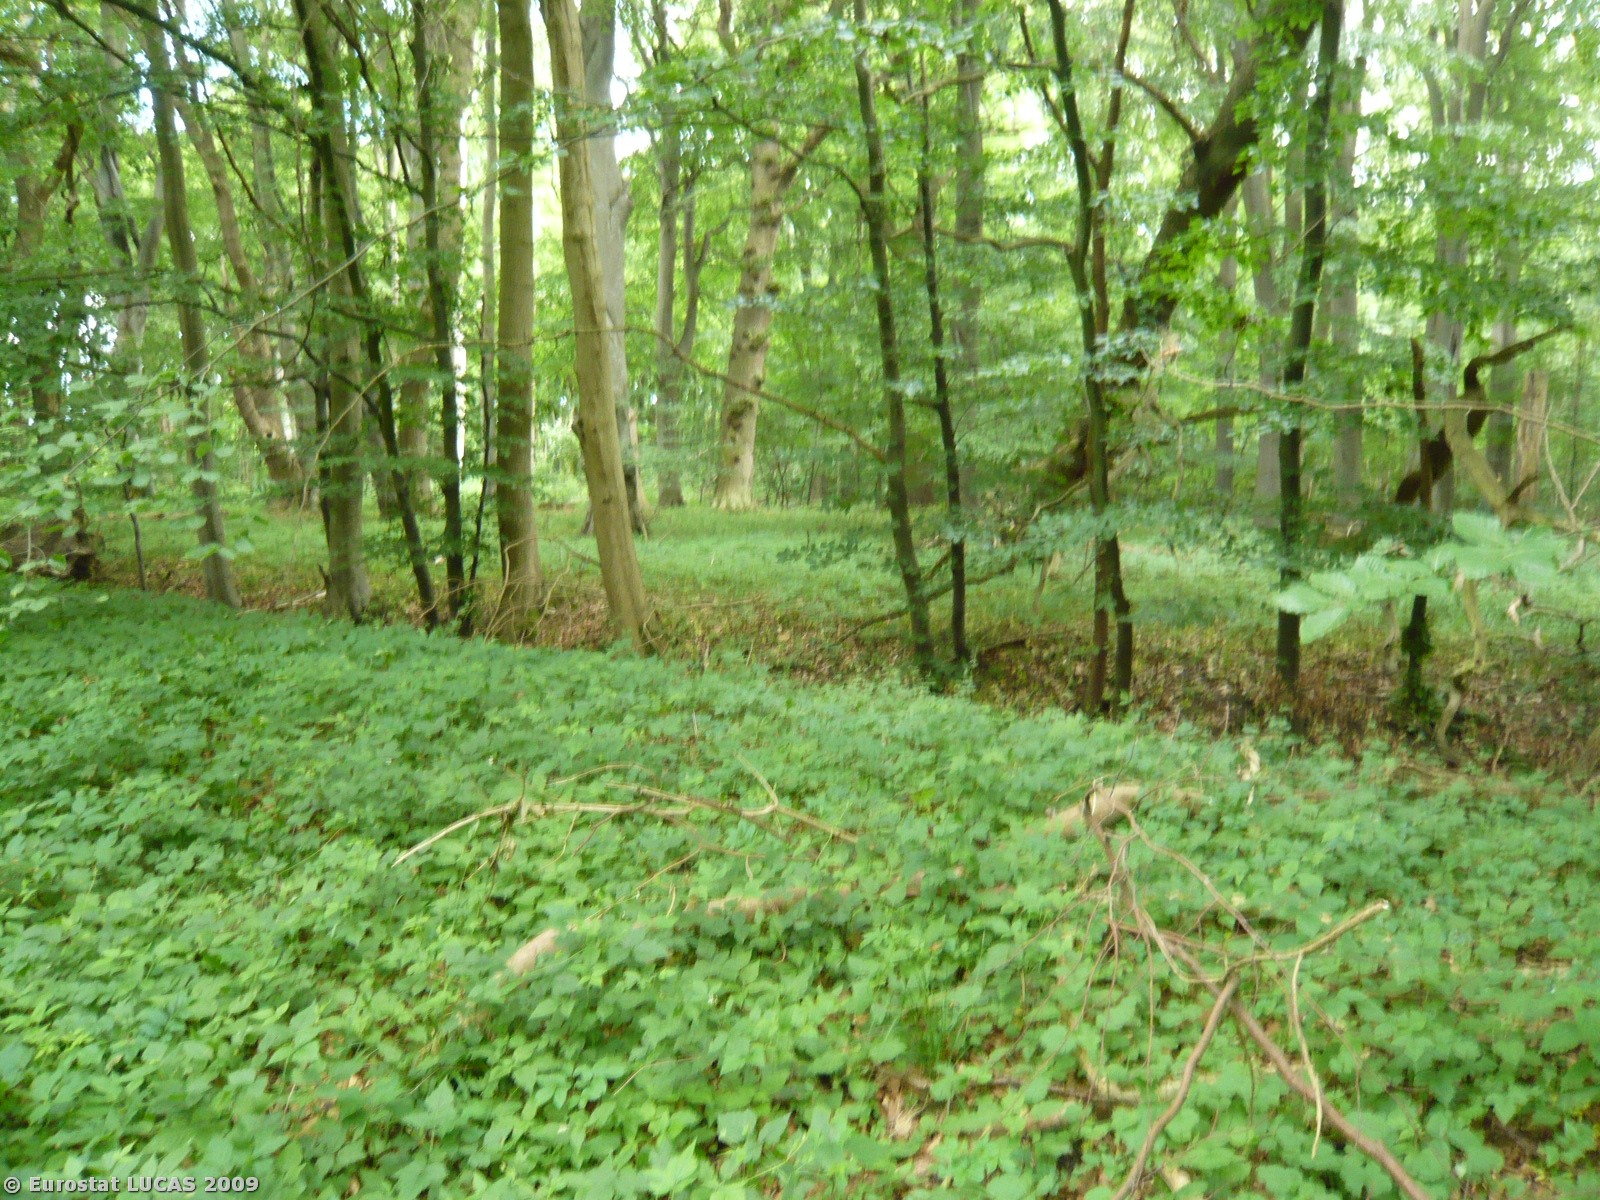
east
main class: Woodland
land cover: Broadleaved woodland
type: mesophytic deciduous forest
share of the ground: > 75 %
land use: Forestry
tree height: > 5 m
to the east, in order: Broadleaved woodland; Tracks; Broadleaved woodland; Tracks; Broadleaved woodland; Inland water bodies
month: June
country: DK
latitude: 54.7747
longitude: 11.6623
